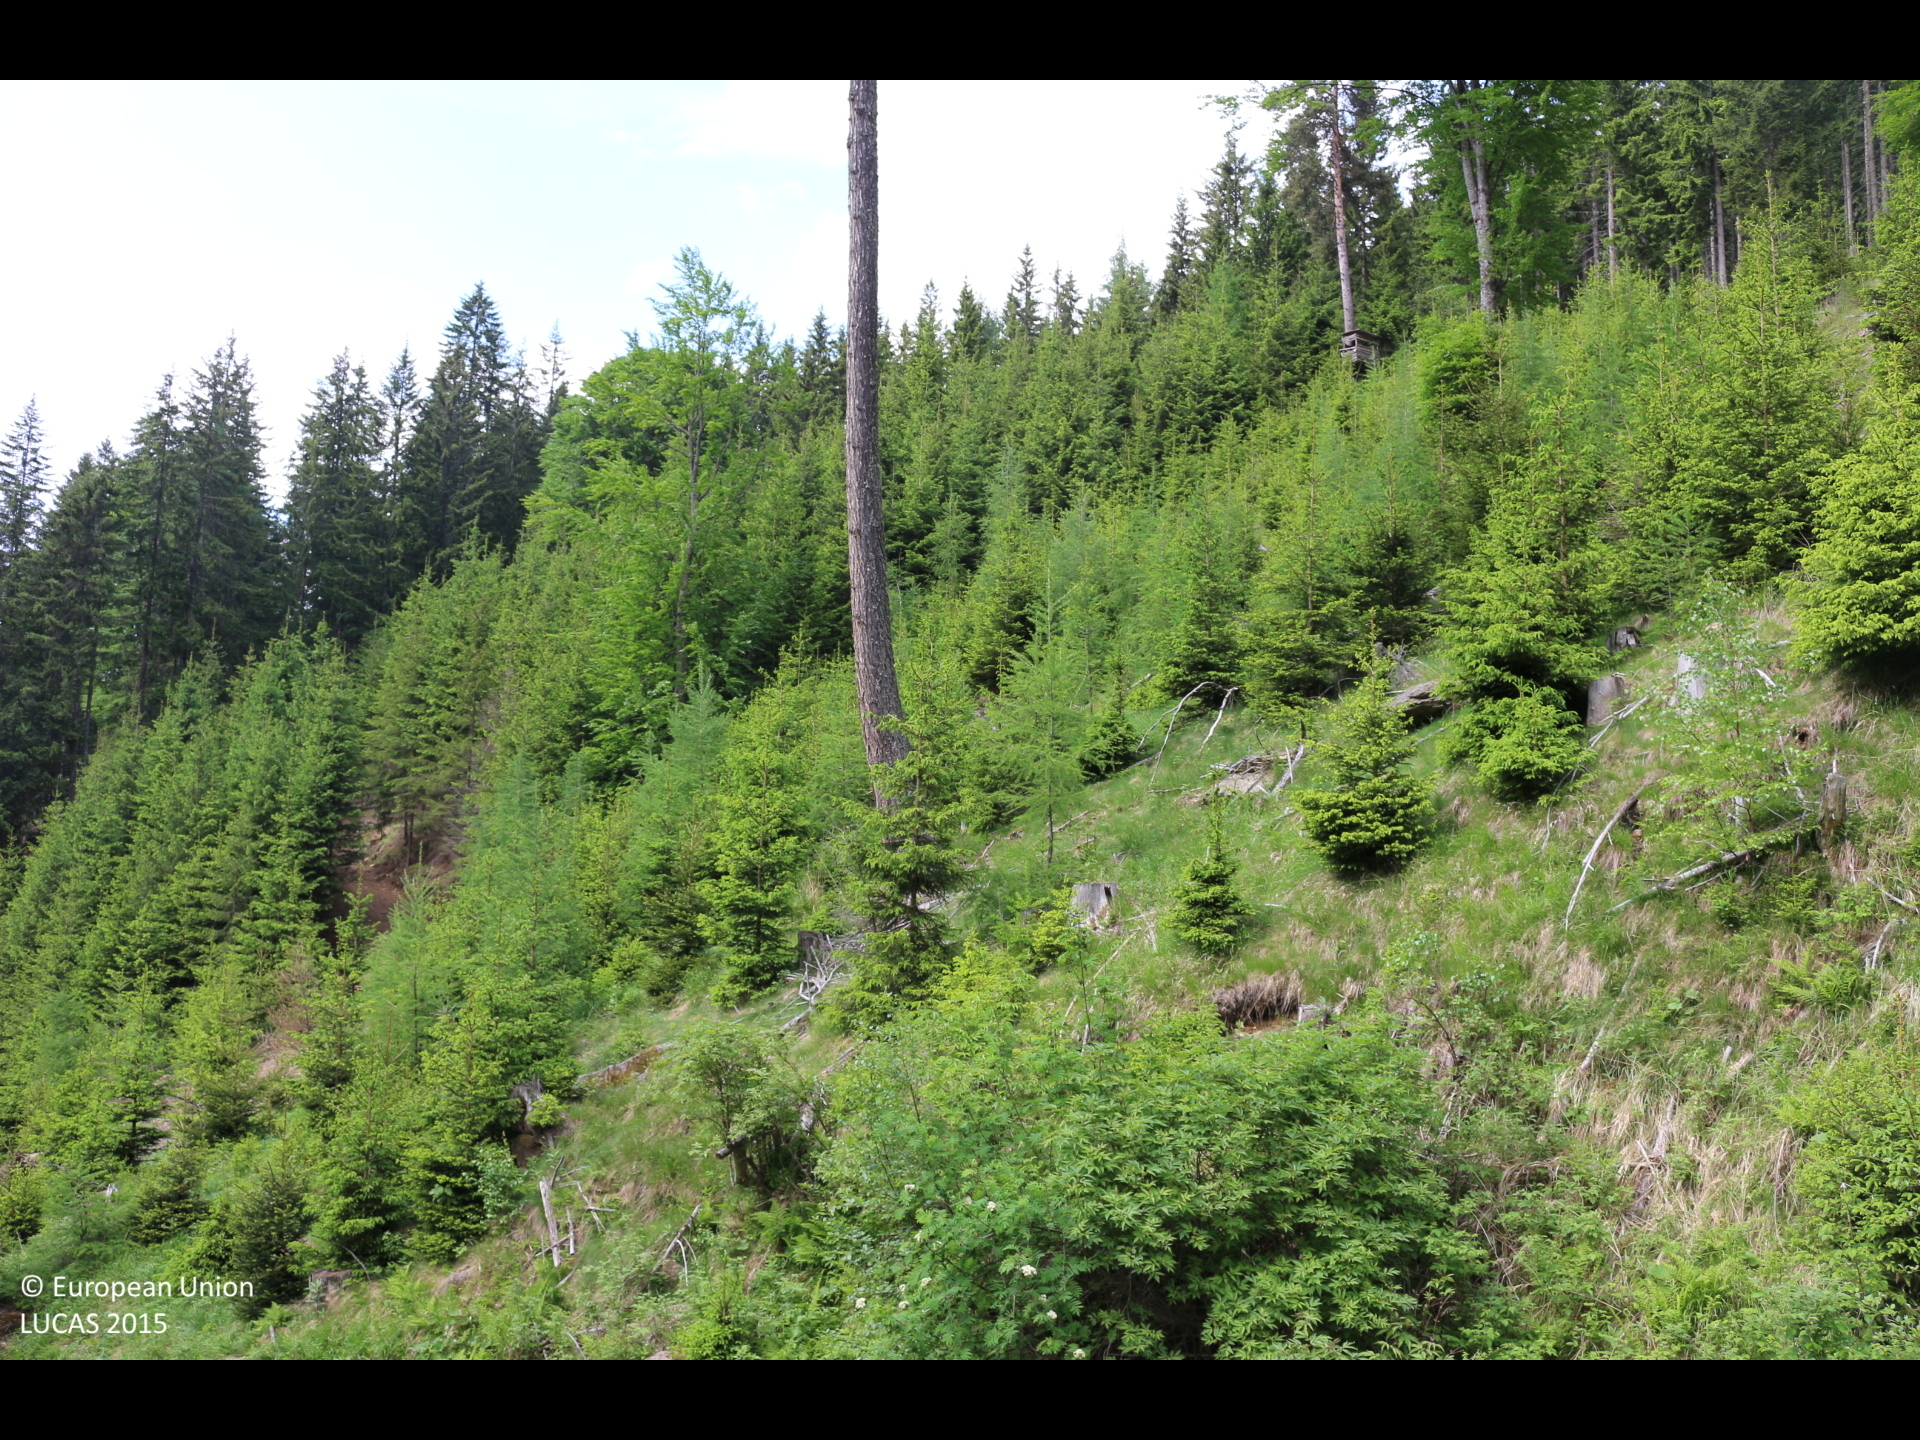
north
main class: Shrubland
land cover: Shrubland without tree cover
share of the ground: 50 - 75 %
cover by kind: shrubs 65 %, herbaceous plants 25 %, consolidated bare surface 10 %
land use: Forestry
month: June
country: AT
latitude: 46.8475
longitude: 14.6011
